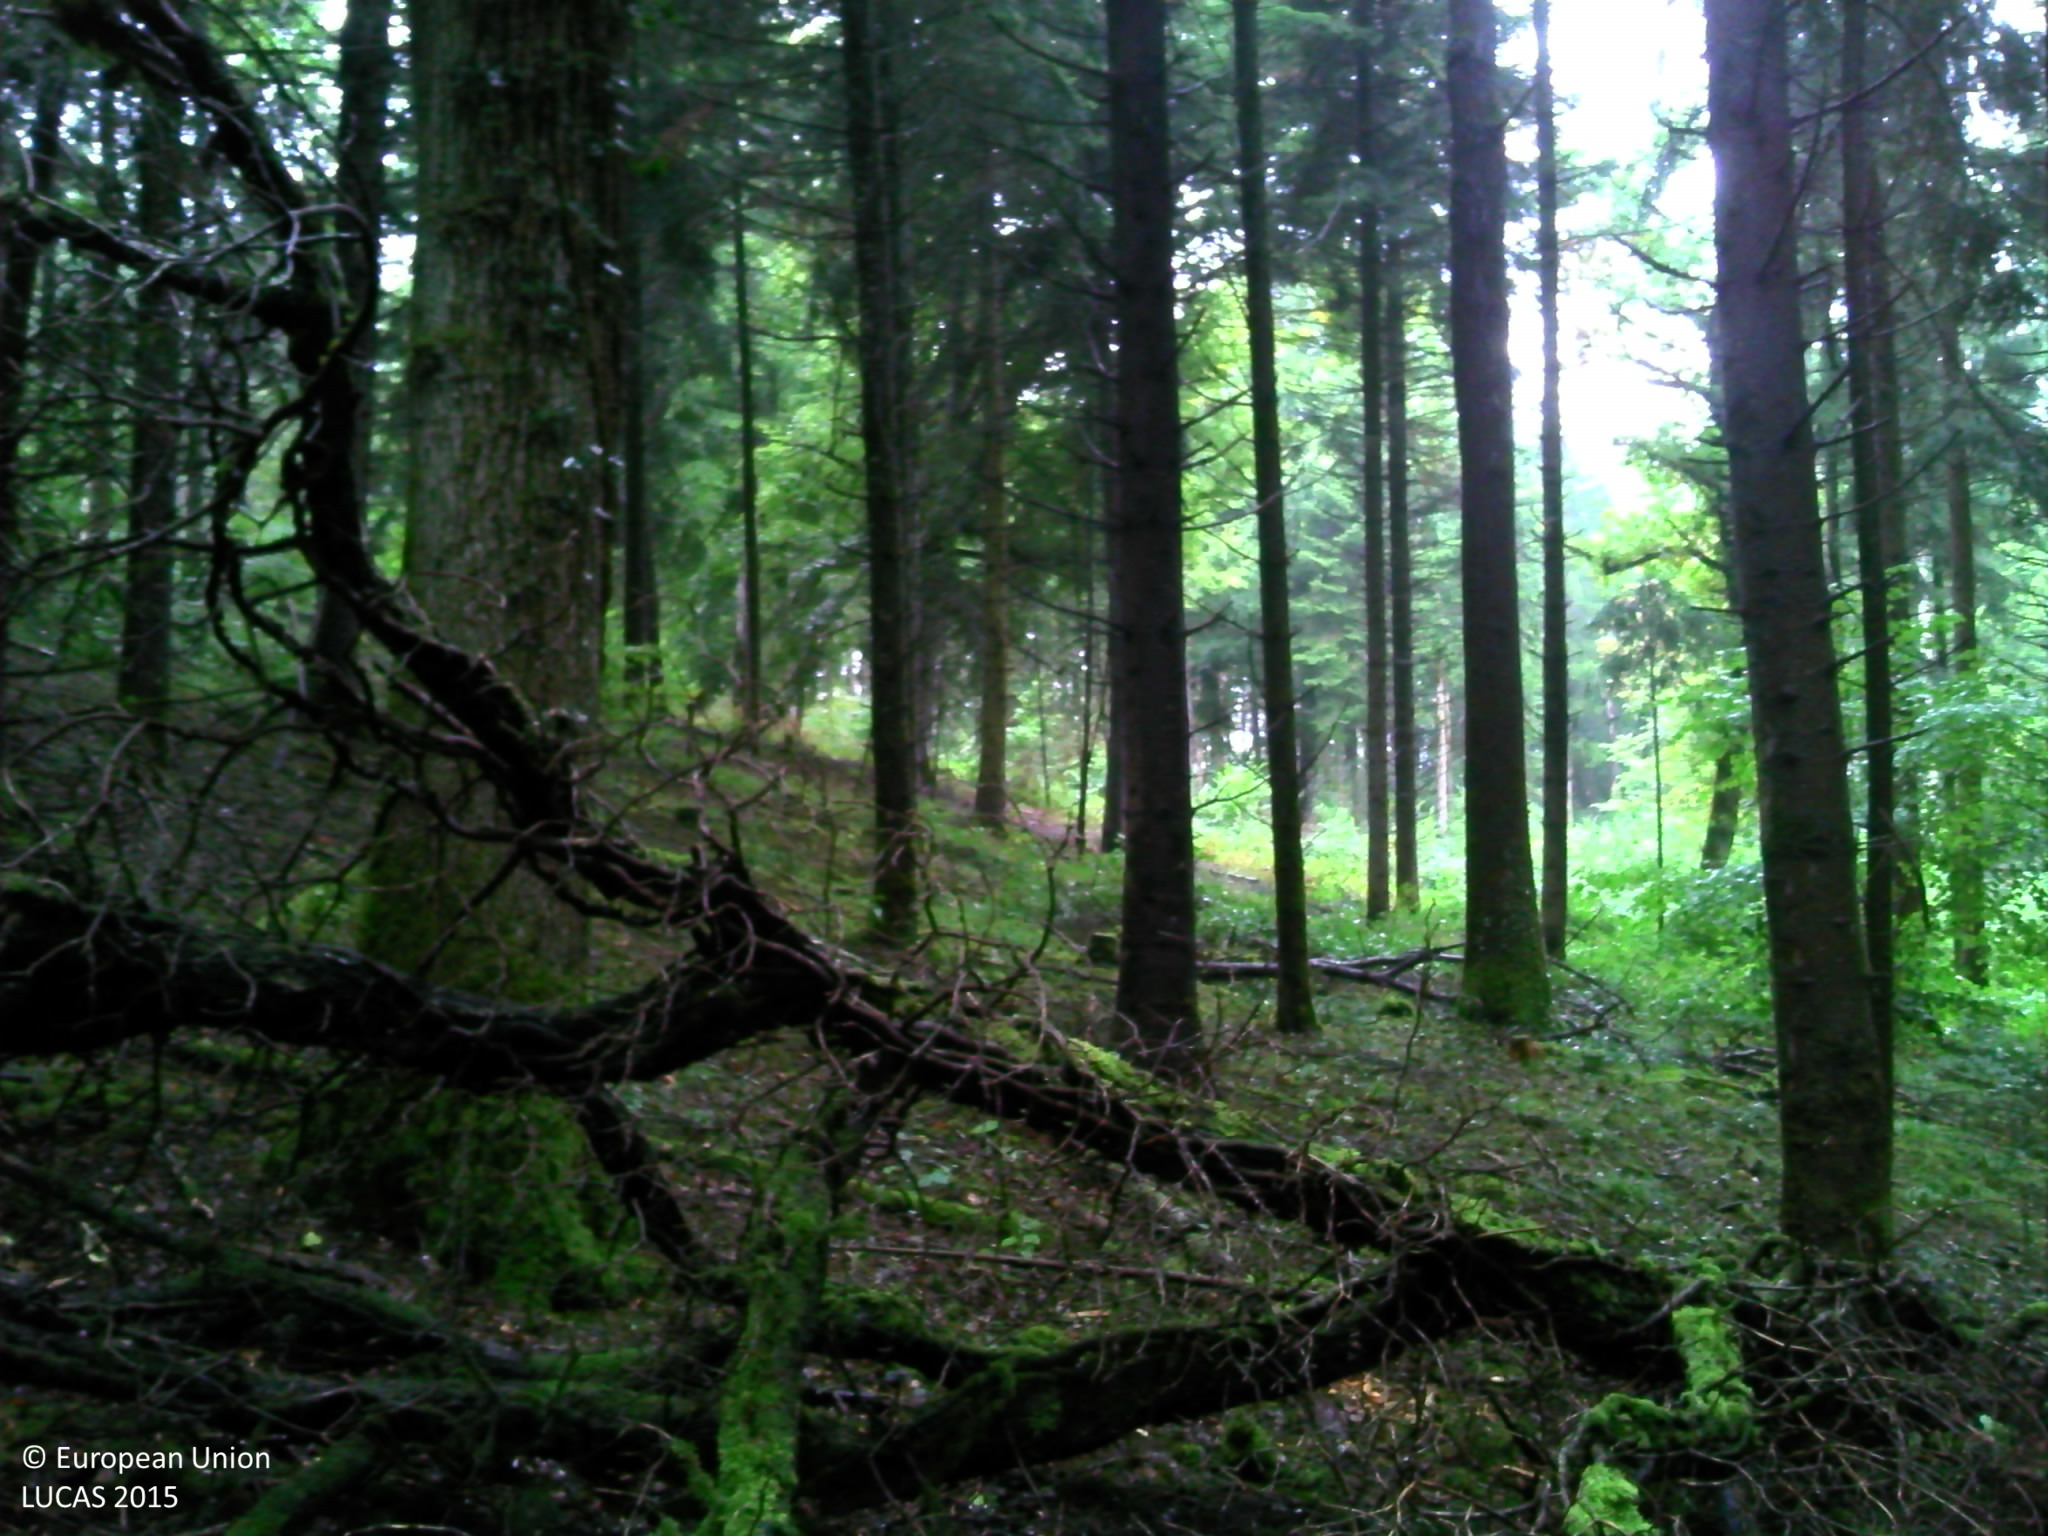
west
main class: Woodland
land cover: Other coniferous woodland
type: mesophytic deciduous forest
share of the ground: > 75 %
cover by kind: coniferous forest trees 95 %, broadleaved forest trees 5 %
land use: Forestry
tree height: > 5 m
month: September
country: FR
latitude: 47.3237
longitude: 4.4025
